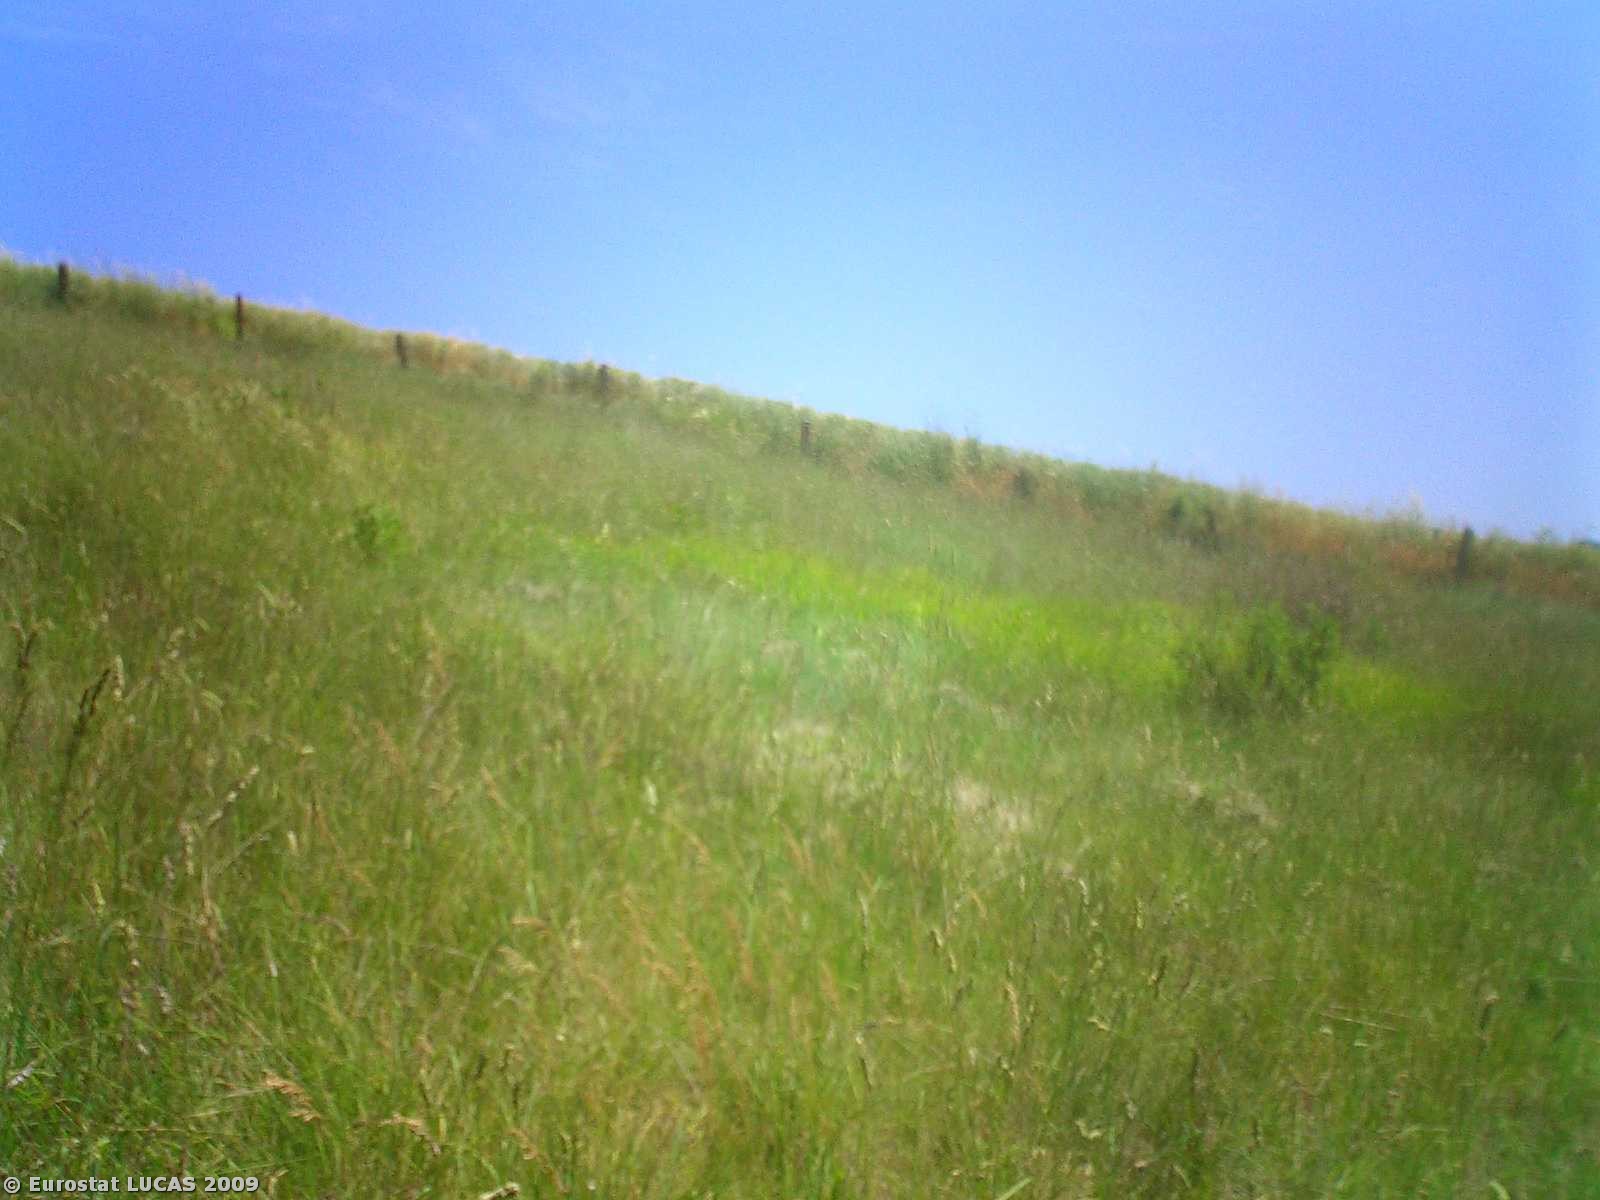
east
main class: Grassland
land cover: Grassland without tree/shrub cover
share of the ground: > 75 %
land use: Agriculture (excluding fallow land and kitchen gardens)
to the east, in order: Grassland without tree/shrub cover; Single bushes/trees; Barley
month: May
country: IT
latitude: 44.2462
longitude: 11.7117
